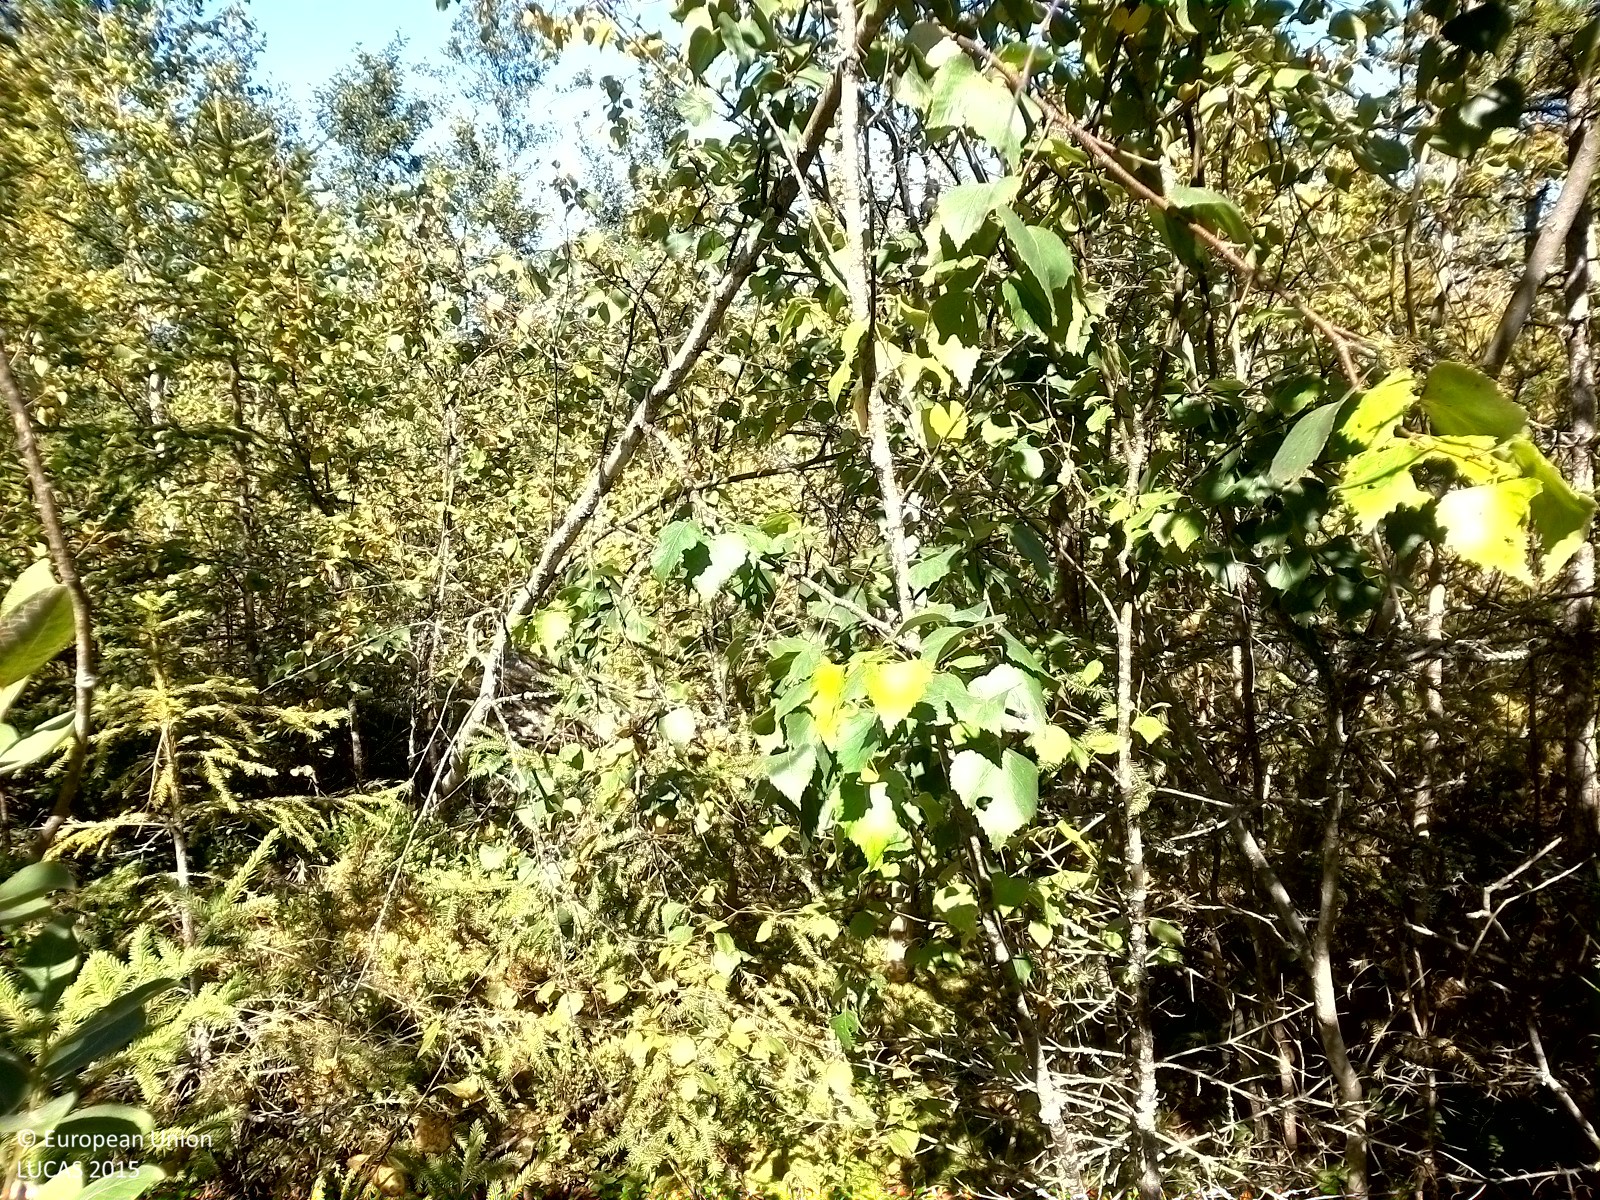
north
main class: Woodland
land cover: Spruce dominated mixed woodland
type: boreal forest
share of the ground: 50 - 75 %
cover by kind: coniferous forest trees 35 %, broadleaved forest trees 25 %, herbaceous plants 20 %, lichens and mosses 20 %
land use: Forestry
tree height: < 5 m
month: August
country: SE
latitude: 59.2111
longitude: 15.4040
